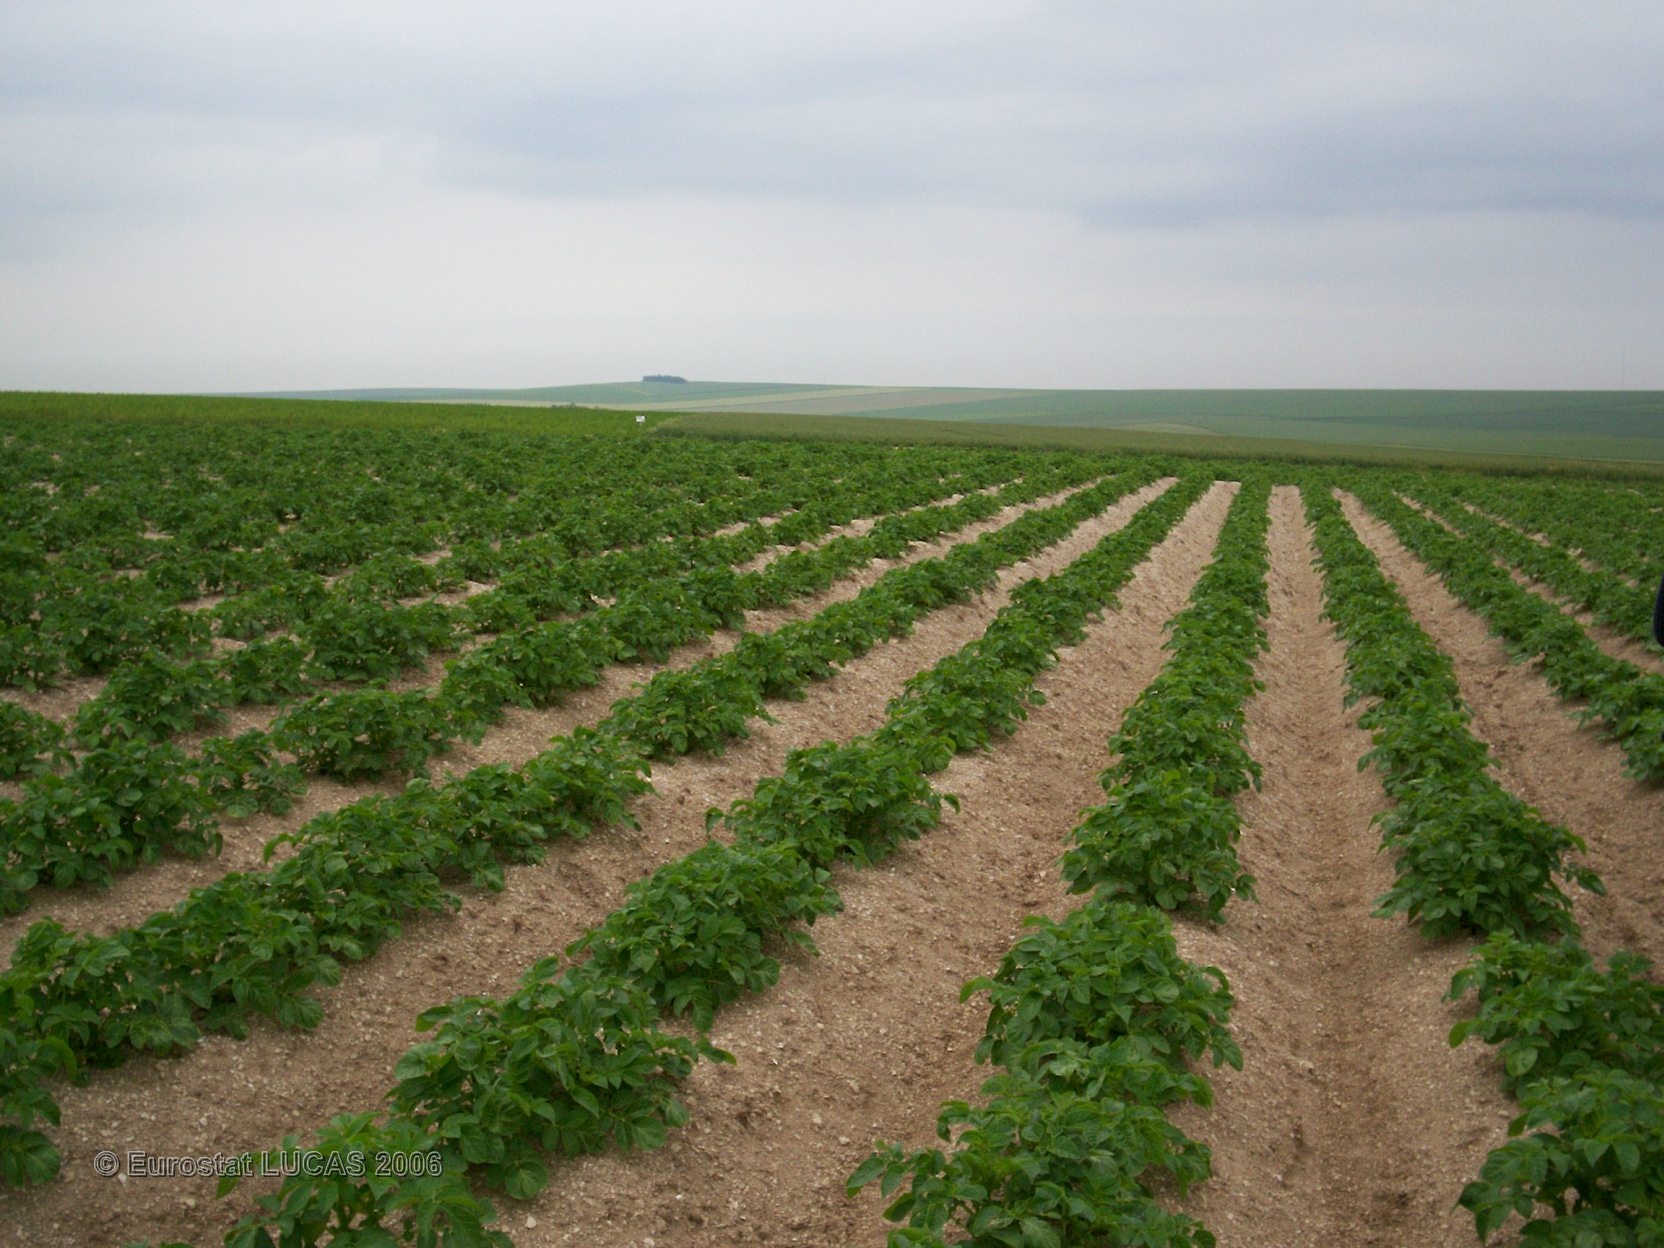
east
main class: Cropland
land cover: Potatoes
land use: Agriculture (excluding fallow land and kitchen gardens)
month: June
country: FR
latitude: 48.7502
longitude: 4.4340
